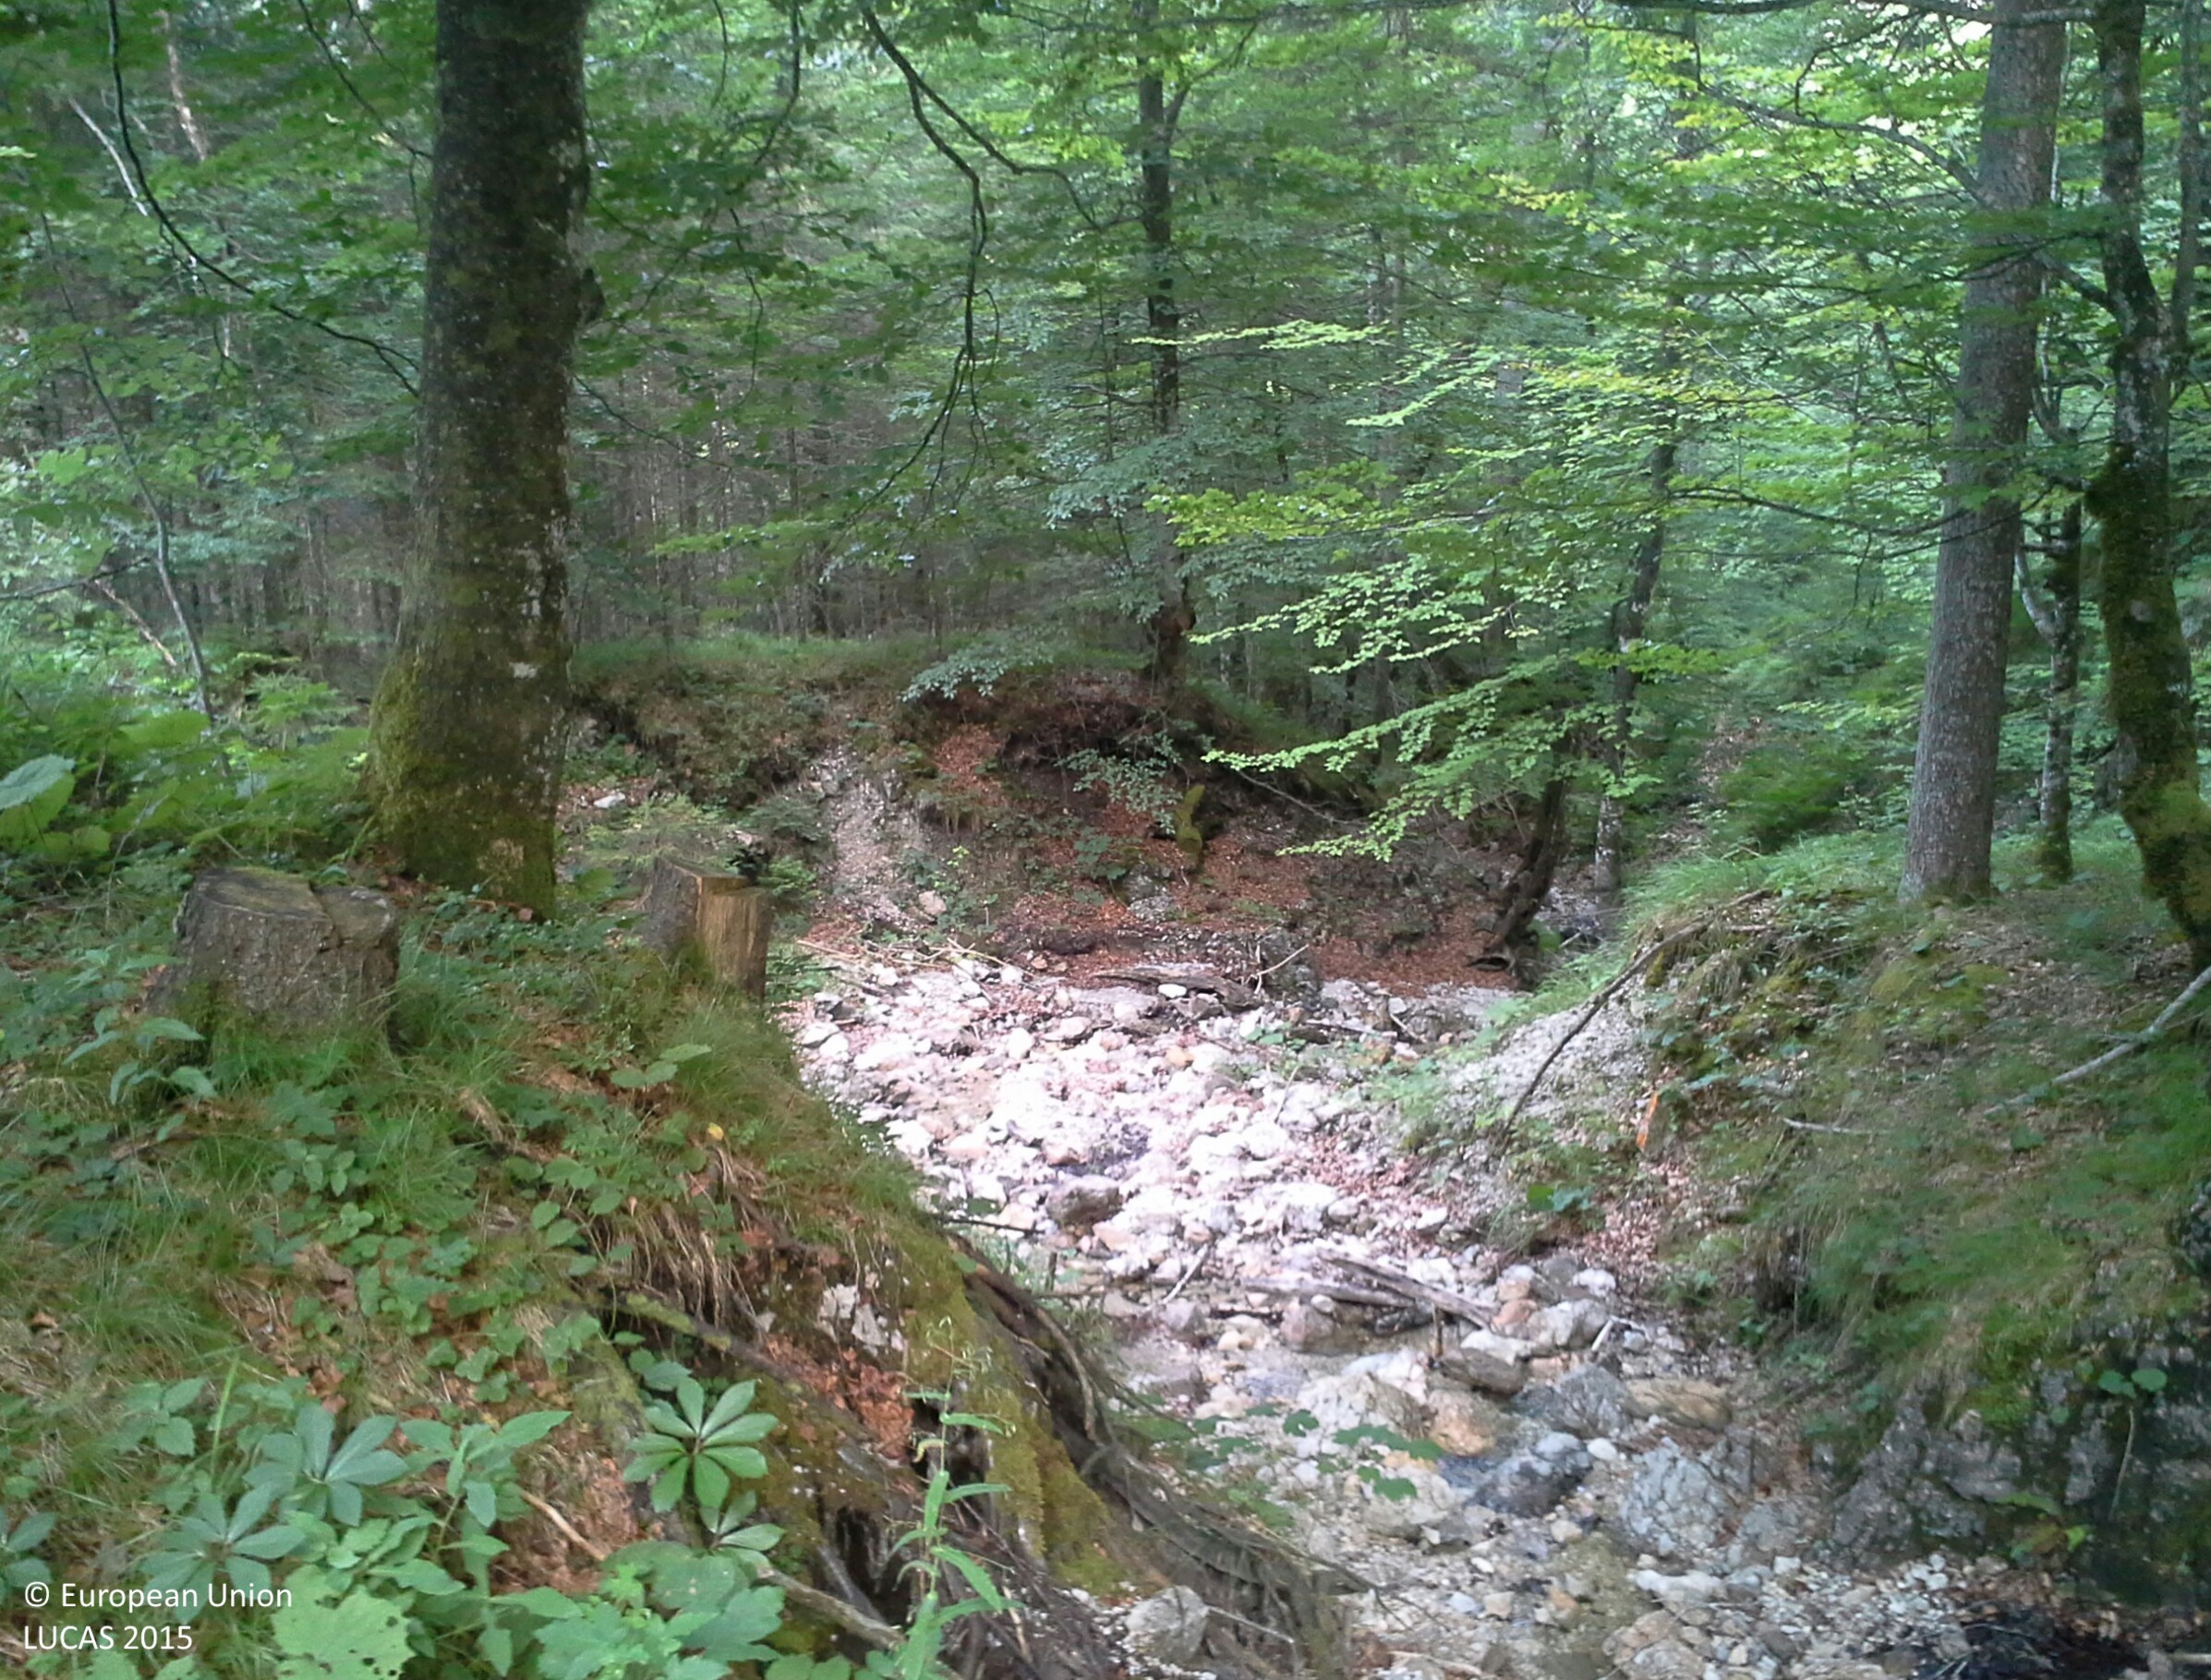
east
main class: Woodland
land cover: Broadleaved woodland
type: mountainous beech forest
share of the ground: > 75 %
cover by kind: broadleaved forest trees 90 %, coniferous forest trees 5 %, shrubs 5 %
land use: Forestry
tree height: > 5 m
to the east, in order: Broadleaved woodland; Rivers and streams; Spruce dominated coniferous woodland; Broadleaved woodland; Rivers and streams; Spruce dominated mixed woodland; Spruce dominated coniferous woodland; Shrubland with sparse tree cover; Spruce dominated mixed woodland; Shrubland with sparse tree cover; Spruce dominated mixed woodland
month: July
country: AT
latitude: 47.7541
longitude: 14.0143
